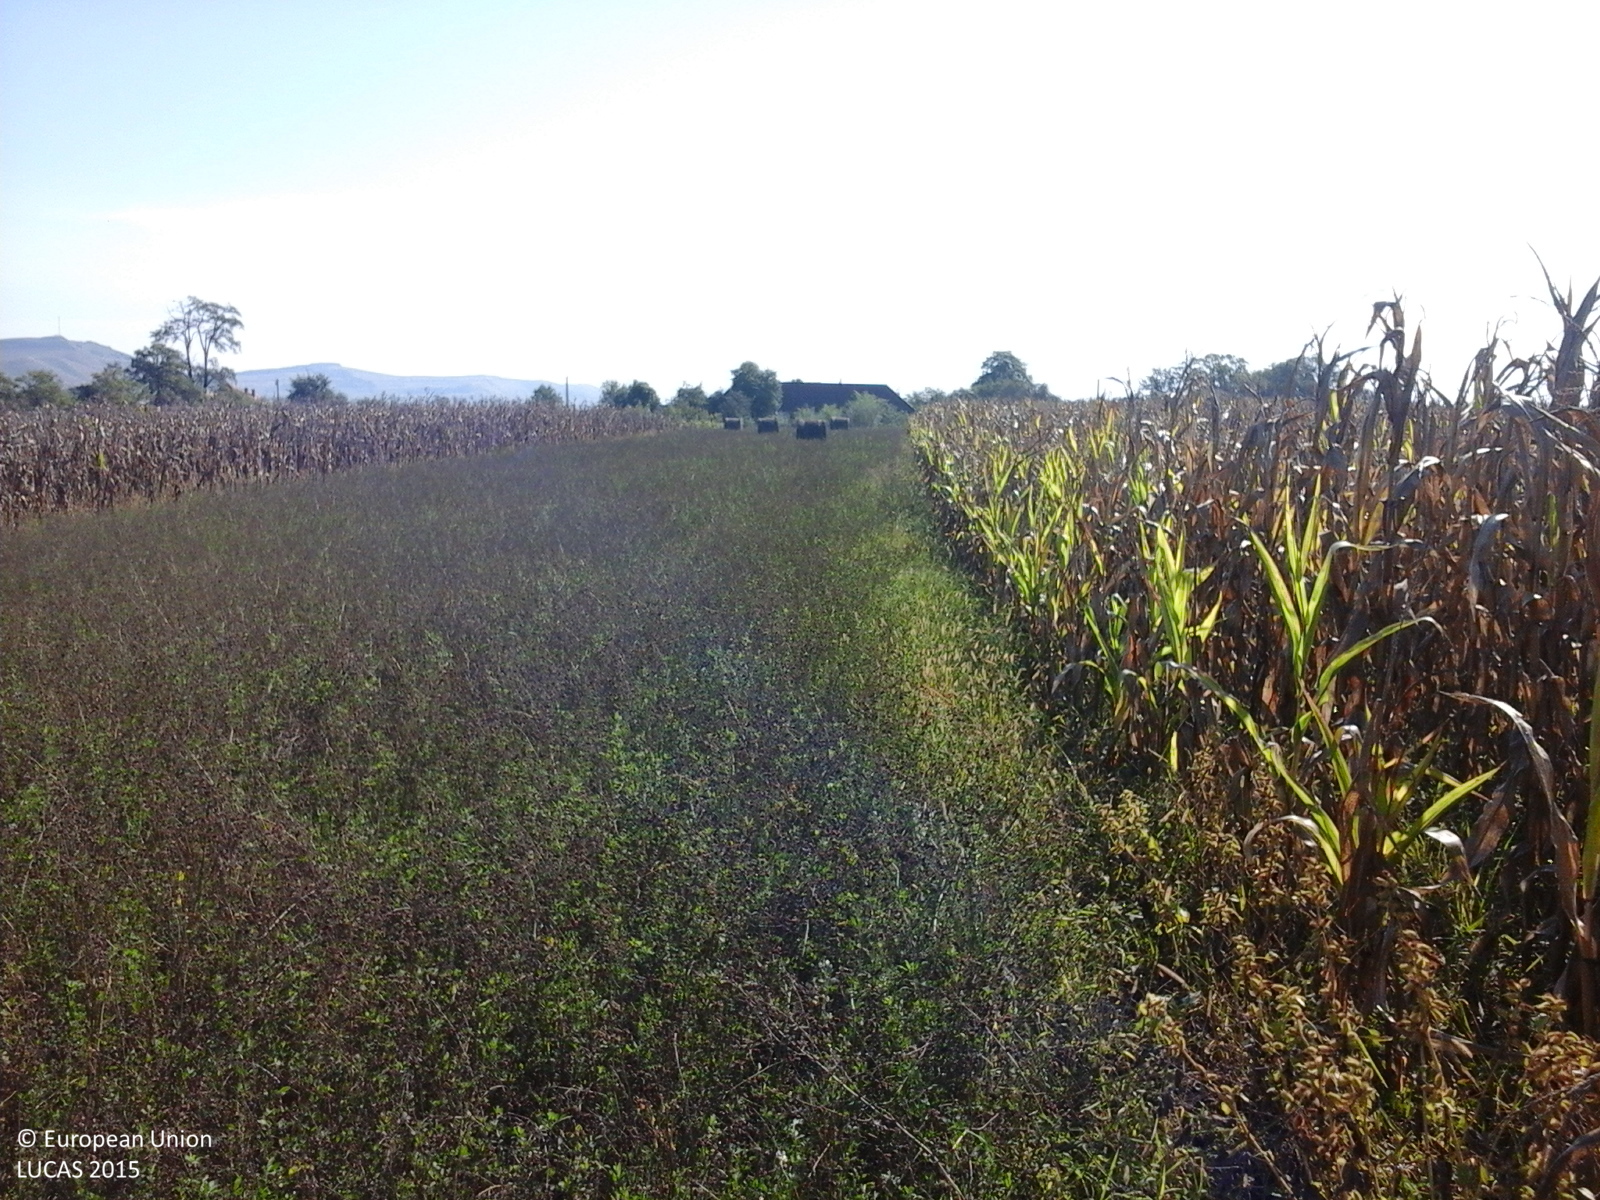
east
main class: Cropland
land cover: Lucerne
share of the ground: > 75 %
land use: Agriculture (excluding fallow land and kitchen gardens)
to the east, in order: Lucerne; Maize; Lucerne; Lines of trees; Artificial constructions in urban areas; Maize
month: October
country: RO
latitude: 46.0673
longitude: 23.8394
